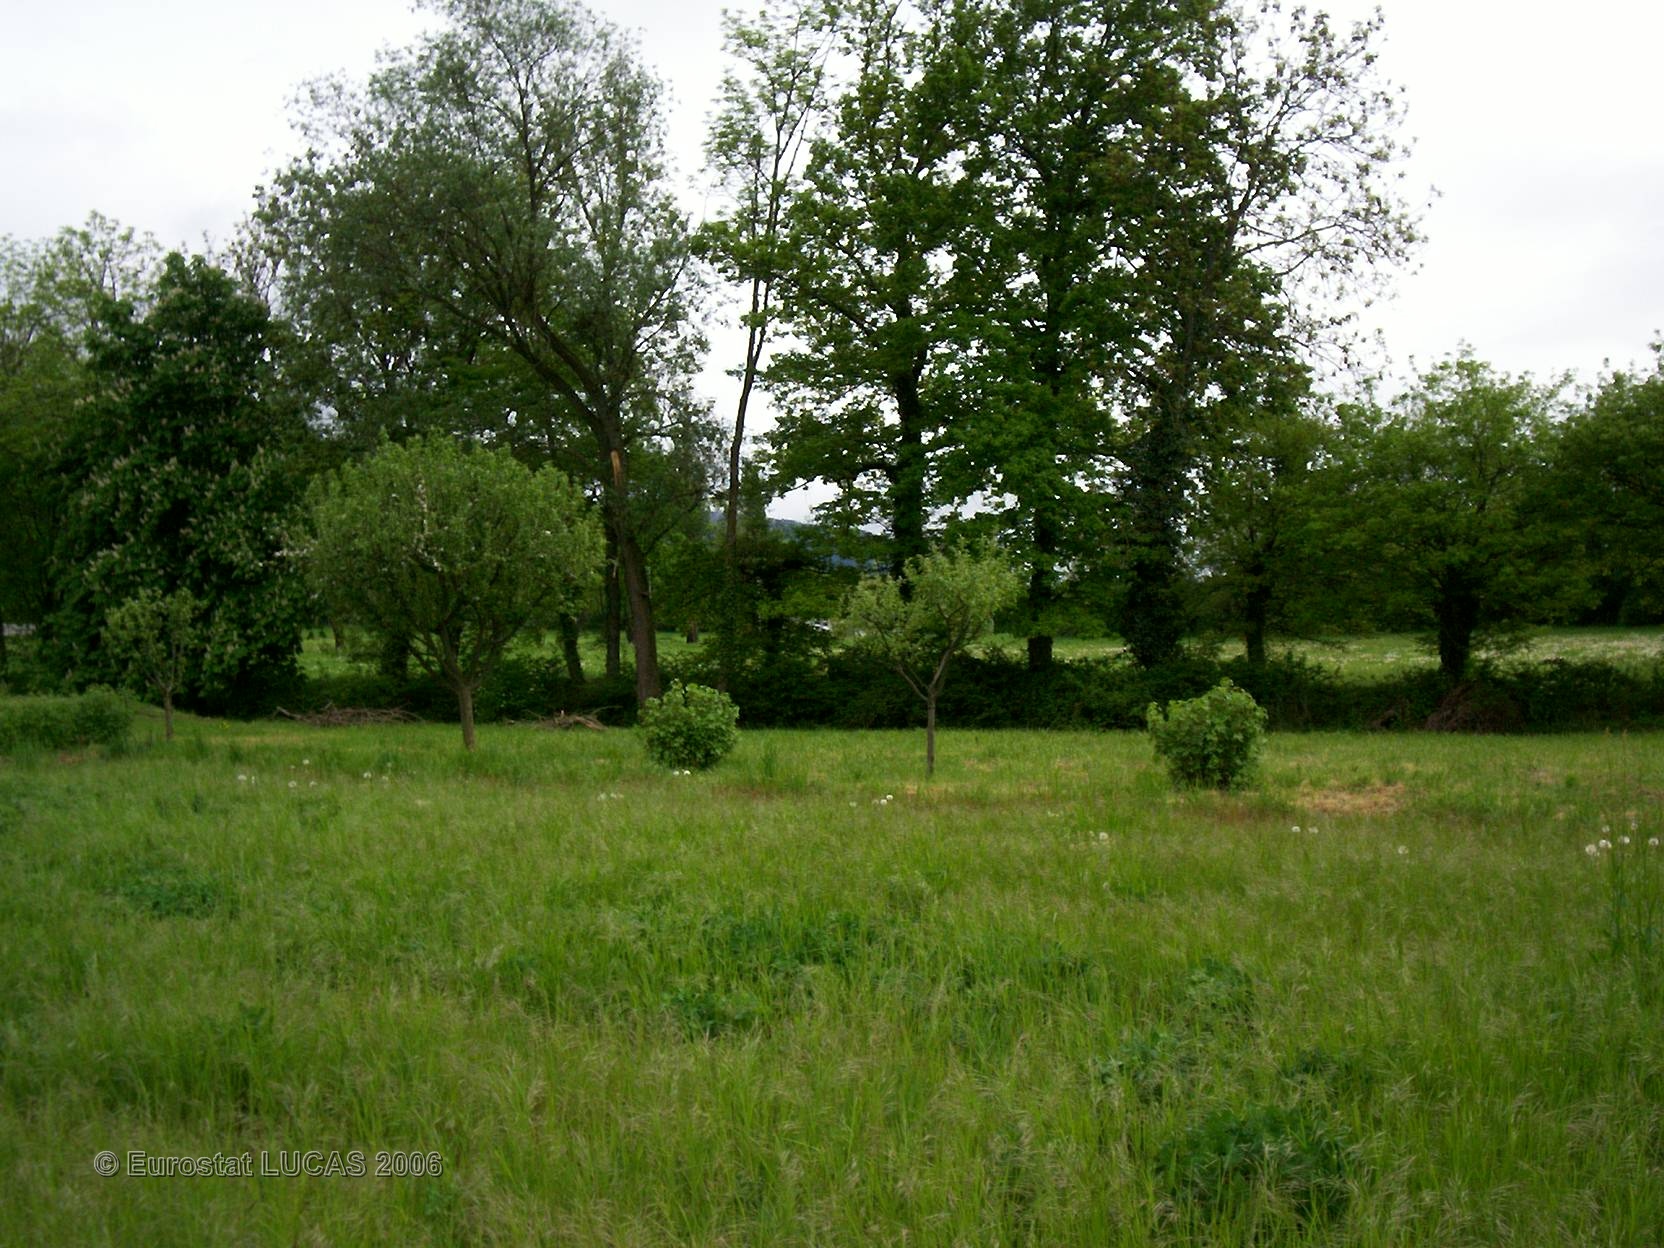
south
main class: Grassland
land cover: Grassland without tree/shrub cover
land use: Agriculture (excluding fallow land and kitchen gardens)
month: May
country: FR
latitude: 46.1181
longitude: 6.1087
